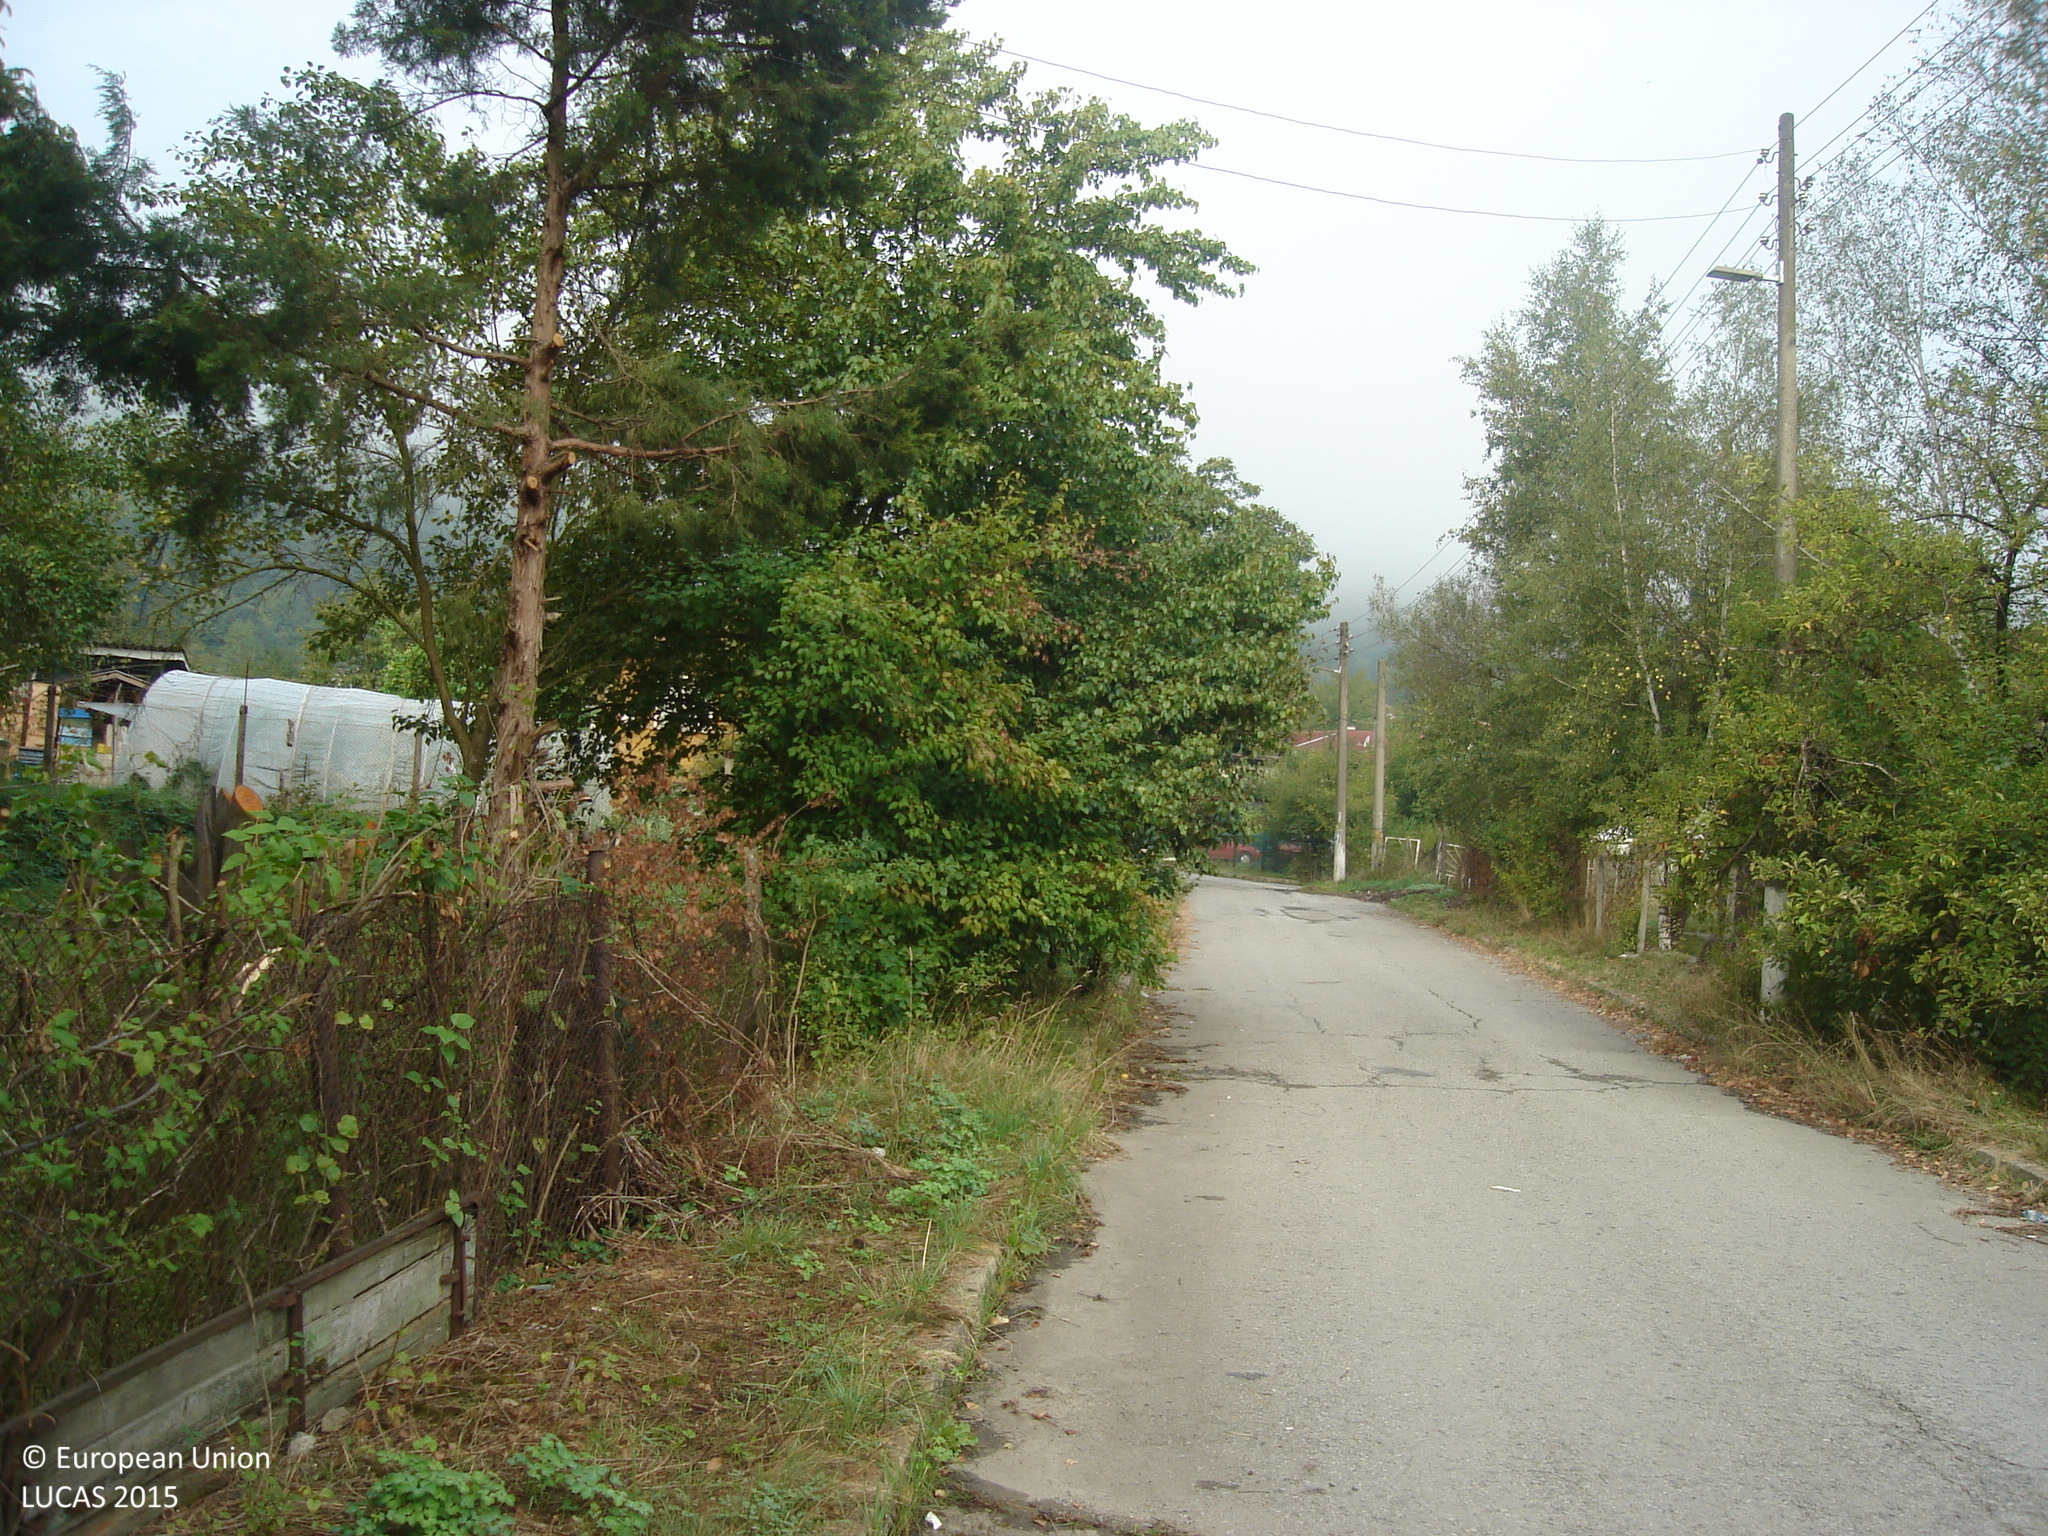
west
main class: Woodland
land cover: Broadleaved woodland
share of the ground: > 75 %
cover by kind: broadleaved forest trees 80 %
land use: Residential
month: September
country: BG
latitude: 42.9314
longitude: 23.3811
